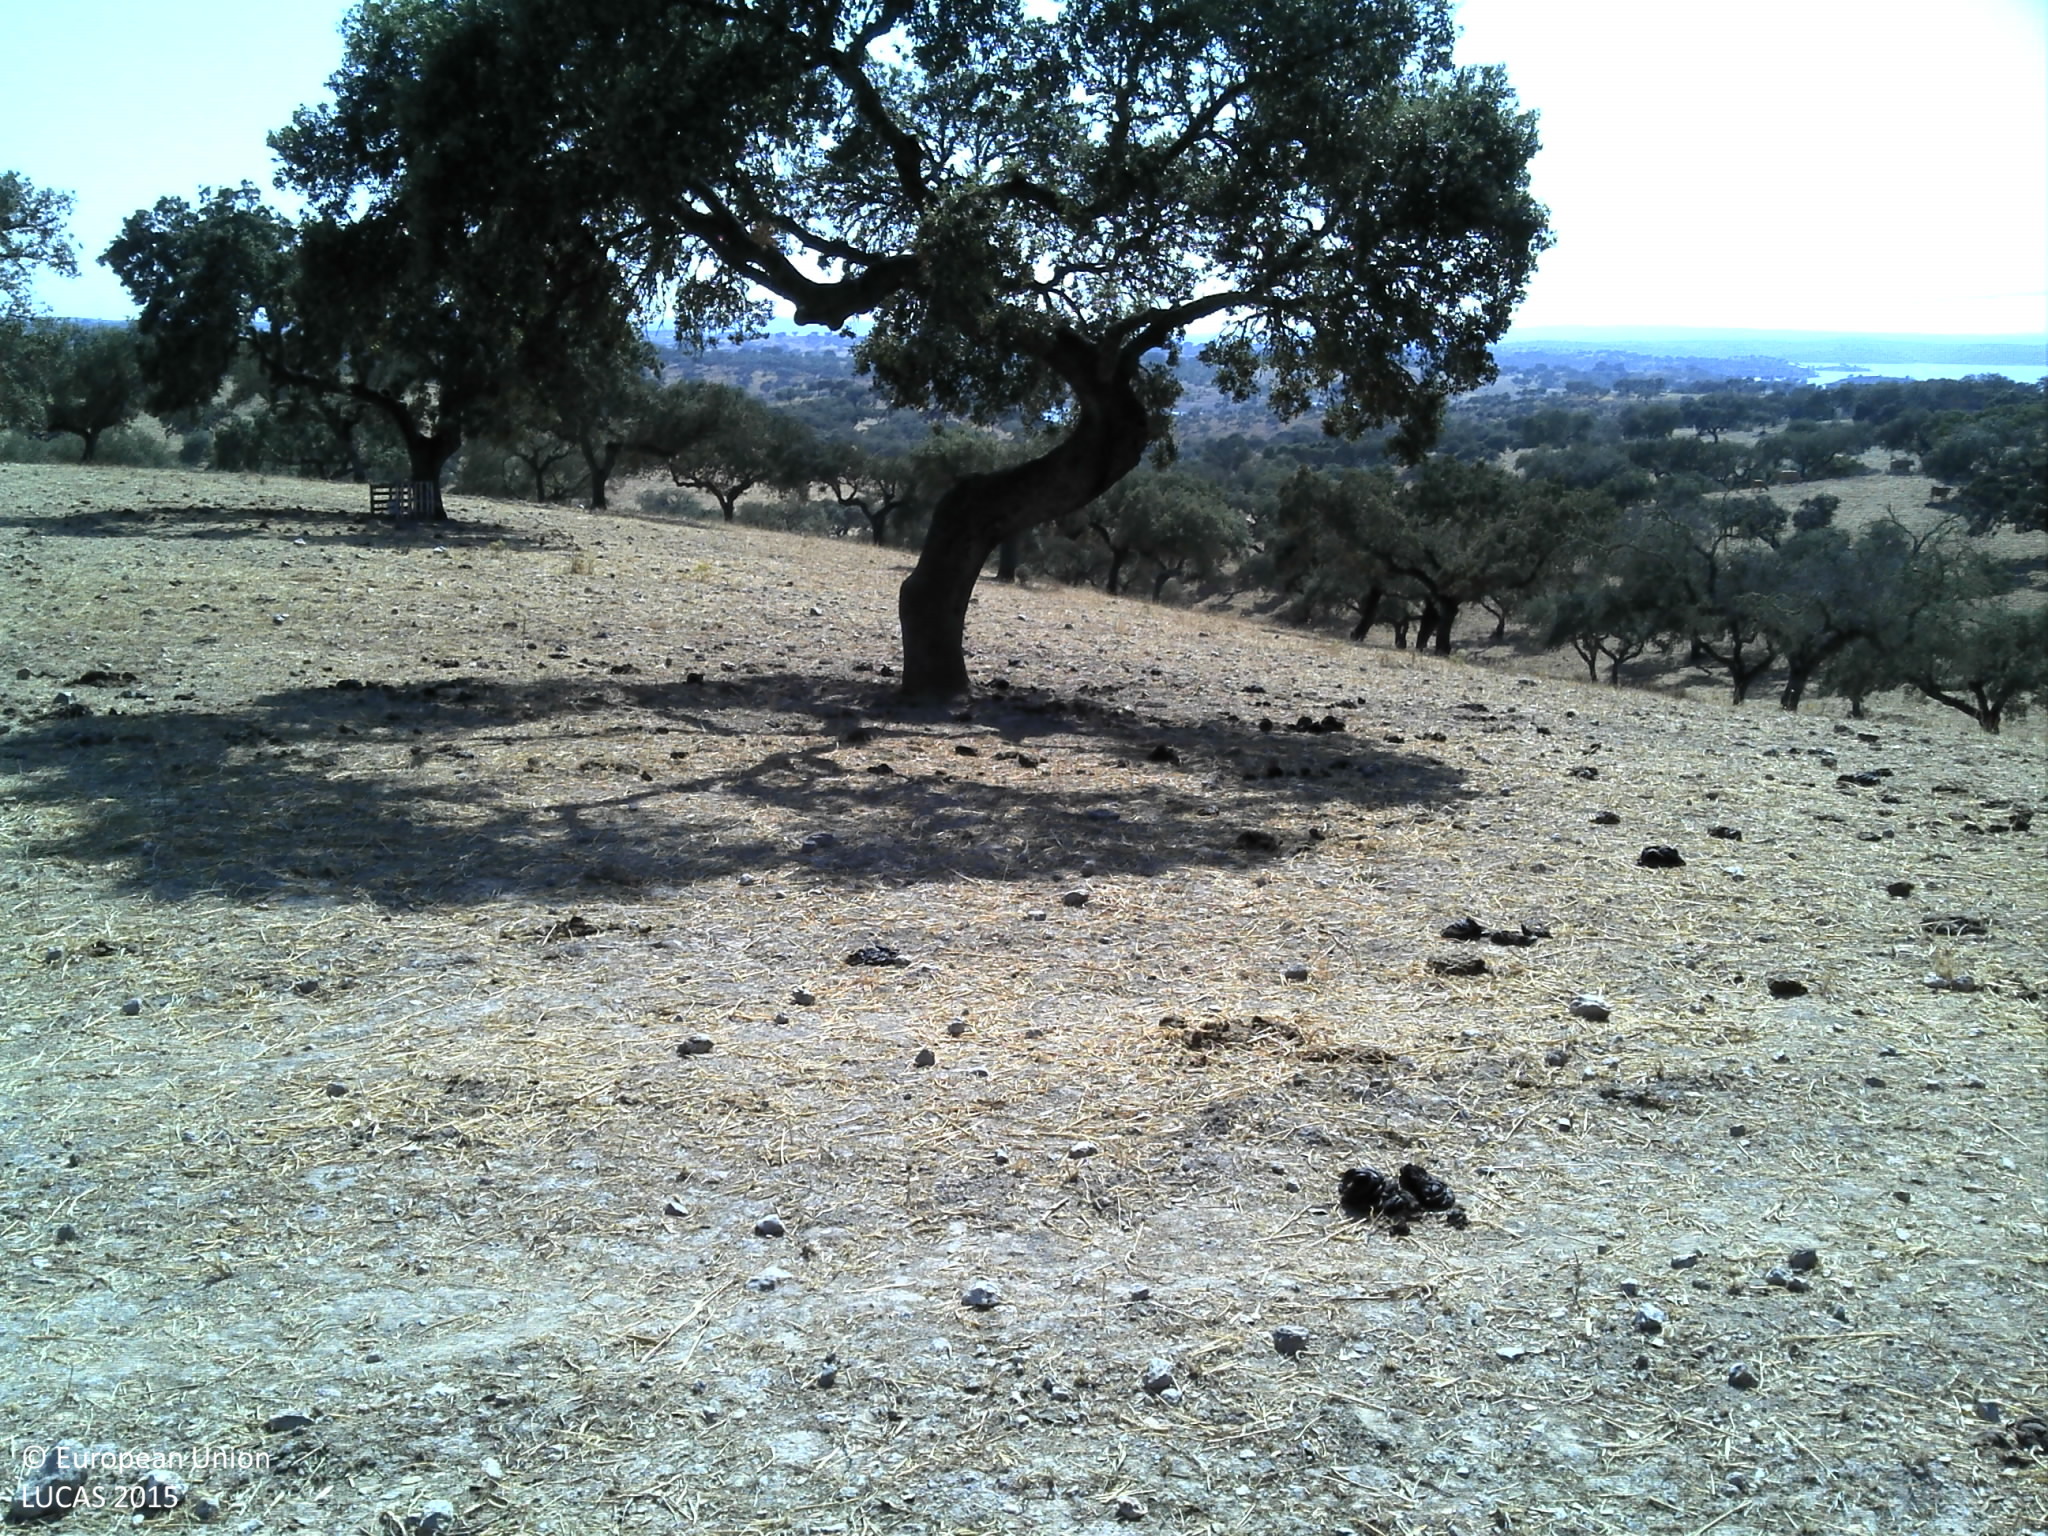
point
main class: Woodland
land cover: Broadleaved woodland
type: broadleaved evergreen forest
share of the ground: 10 - 25 %
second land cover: Grassland without tree/shrub cover
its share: < 10 %
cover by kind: broadleaved forest trees 95 %, herbaceous plants 5 %
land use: Agriculture (excluding fallow land and kitchen gardens)
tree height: > 5 m
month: June
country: PT
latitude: 38.2375
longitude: -7.3988
